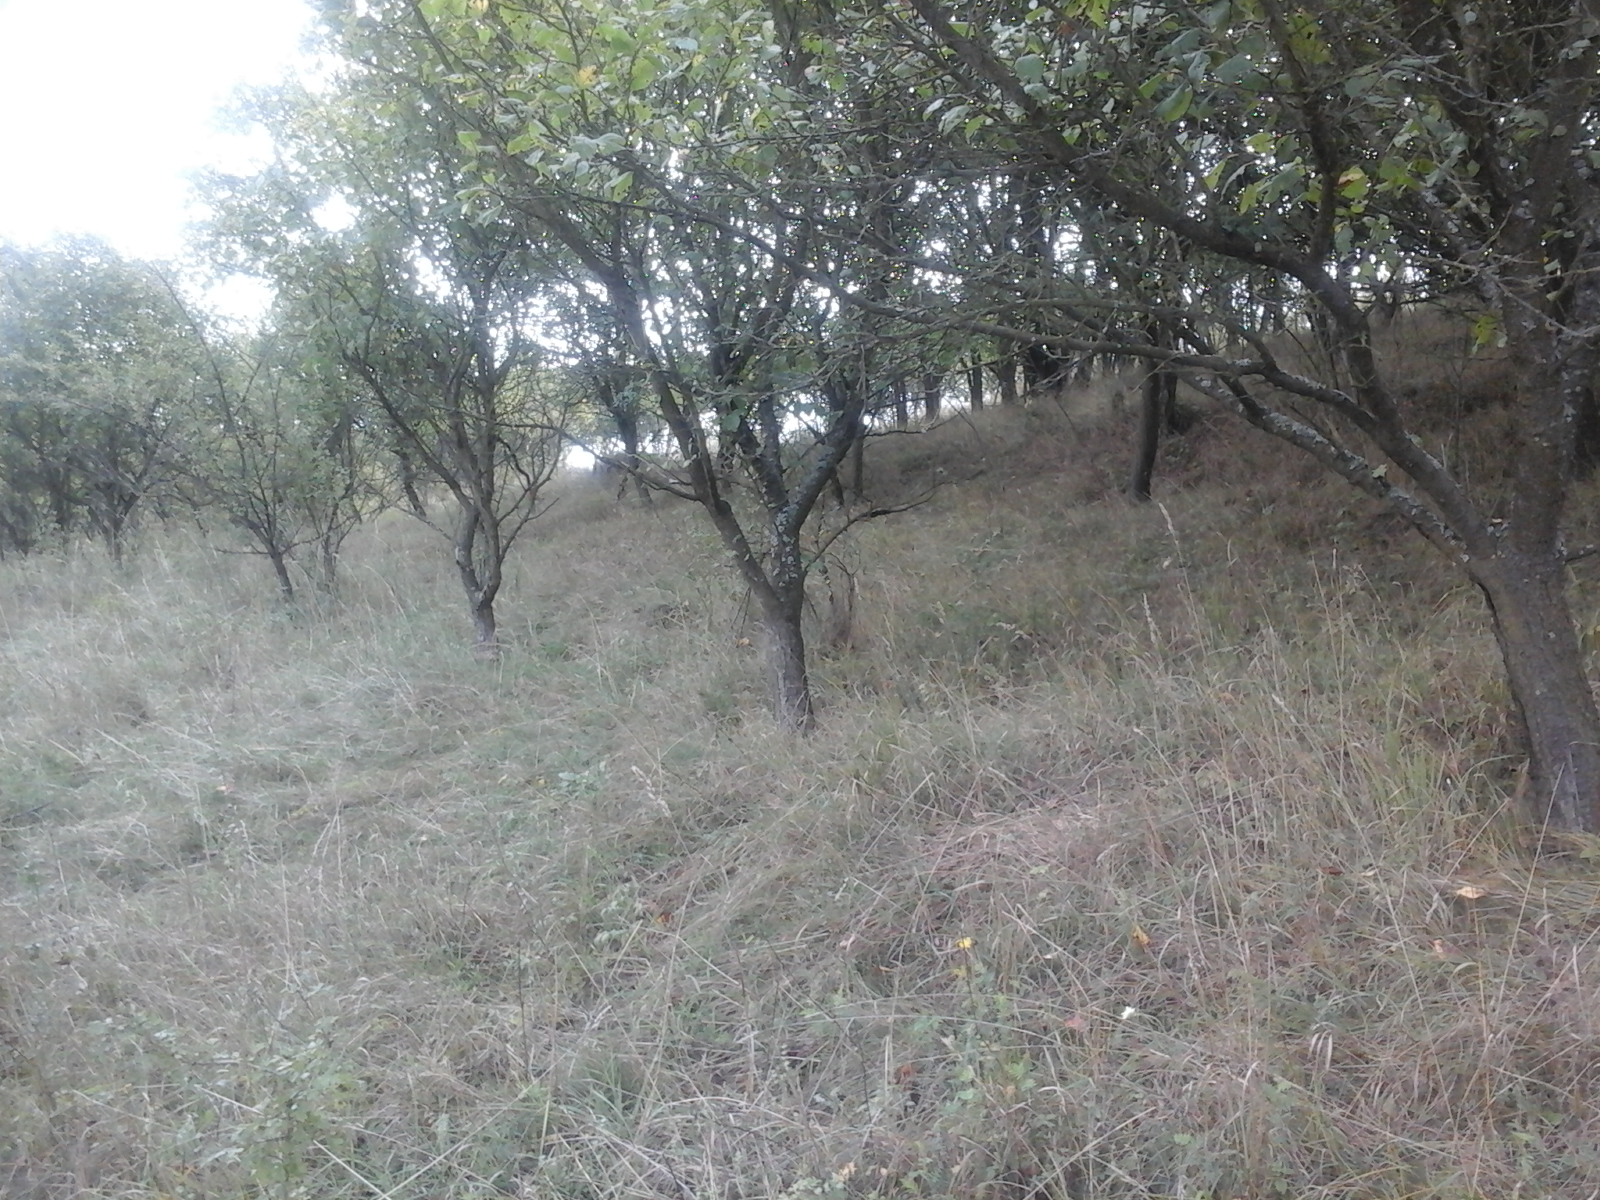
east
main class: Cropland
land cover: Other fruit trees and berries
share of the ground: > 75 %
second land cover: Grassland without tree/shrub cover
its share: > 75 %
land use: Agriculture (excluding fallow land and kitchen gardens)
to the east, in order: Other fruit trees and berries; Grassland without tree/shrub cover; Shrubland without tree cover; Grassland with sparse tree/shrub cover; Shrubland without tree cover; Grassland without tree/shrub cover
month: September
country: RO
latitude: 45.7222
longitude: 22.9663
